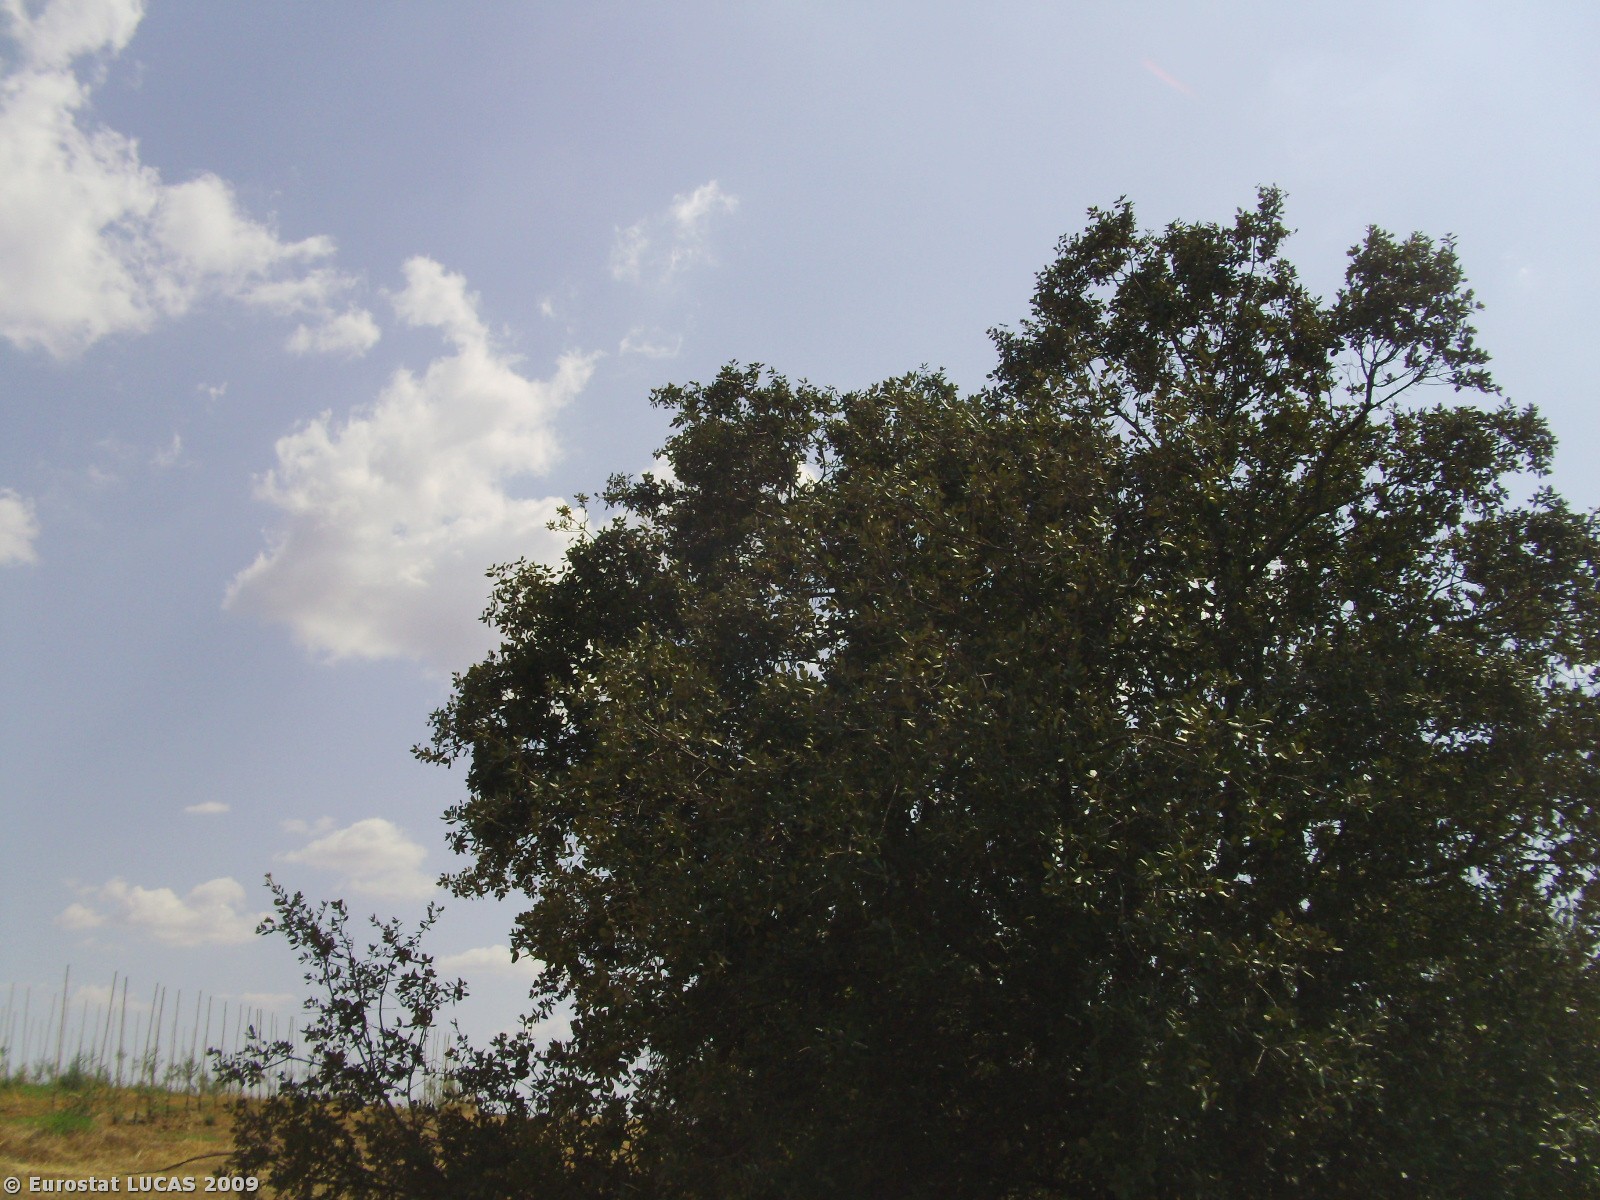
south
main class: Cropland
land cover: Olive groves
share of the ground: 50 - 75 %
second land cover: Spontaneously vegetated surfaces
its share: 50 - 75 %
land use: Agriculture (excluding fallow land and kitchen gardens)
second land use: Fallow land
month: August
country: PT
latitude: 38.3436
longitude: -7.9187
